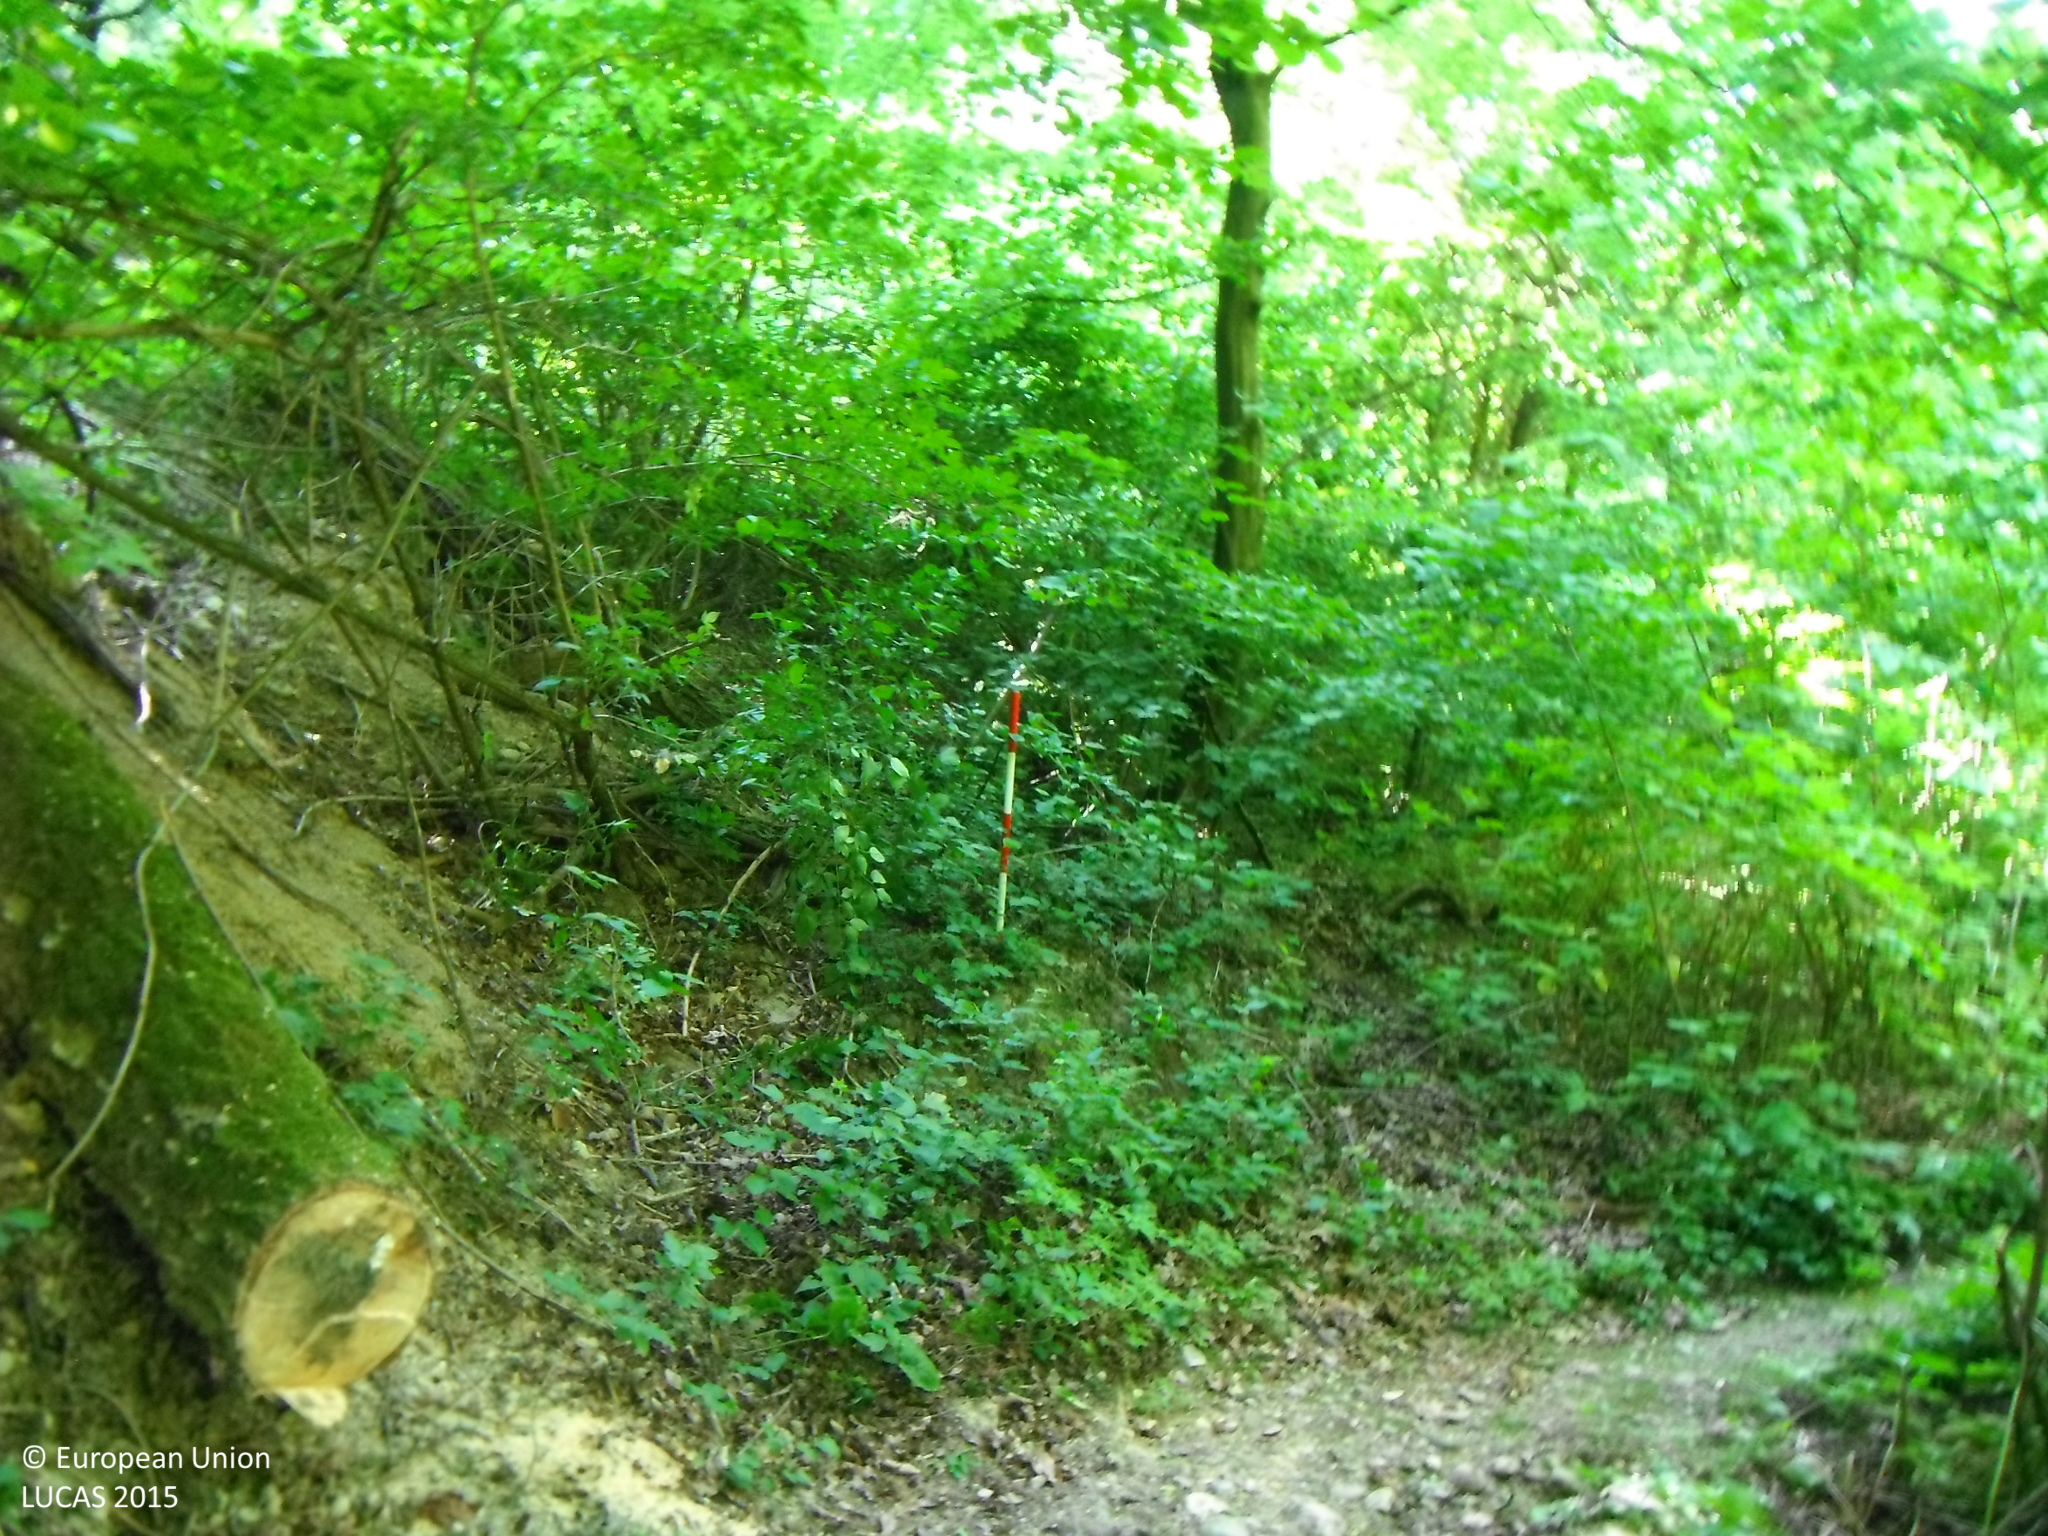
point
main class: Woodland
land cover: Broadleaved woodland
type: mesophytic deciduous forest
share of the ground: > 75 %
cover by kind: broadleaved forest trees 80 %, shrubs 20 %
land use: Semi-natural and natural areas not in use
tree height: > 5 m
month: June
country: SK
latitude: 48.7139
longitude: 21.2846
